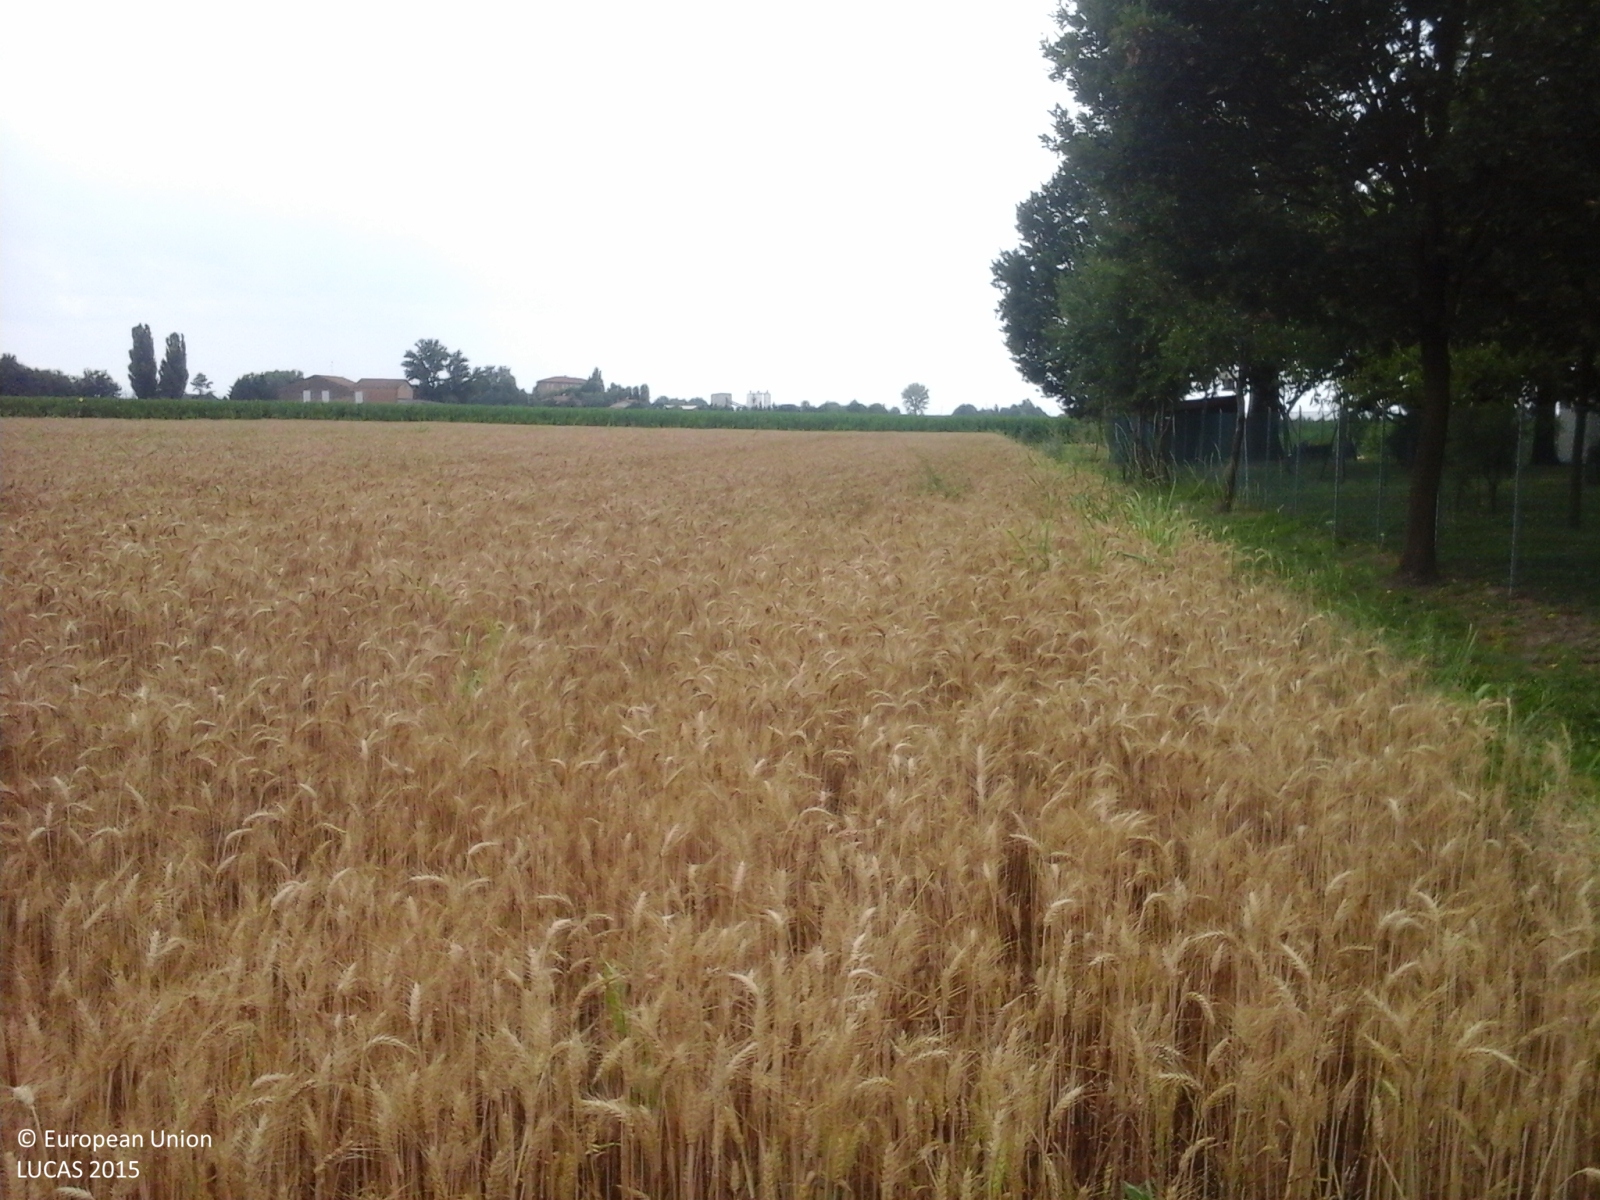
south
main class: Woodland
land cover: Broadleaved woodland
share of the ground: > 75 %
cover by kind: broadleaved forest trees 90 %, herbaceous plants 10 %
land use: Residential
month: June
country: IT
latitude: 44.7784
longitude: 11.0215
